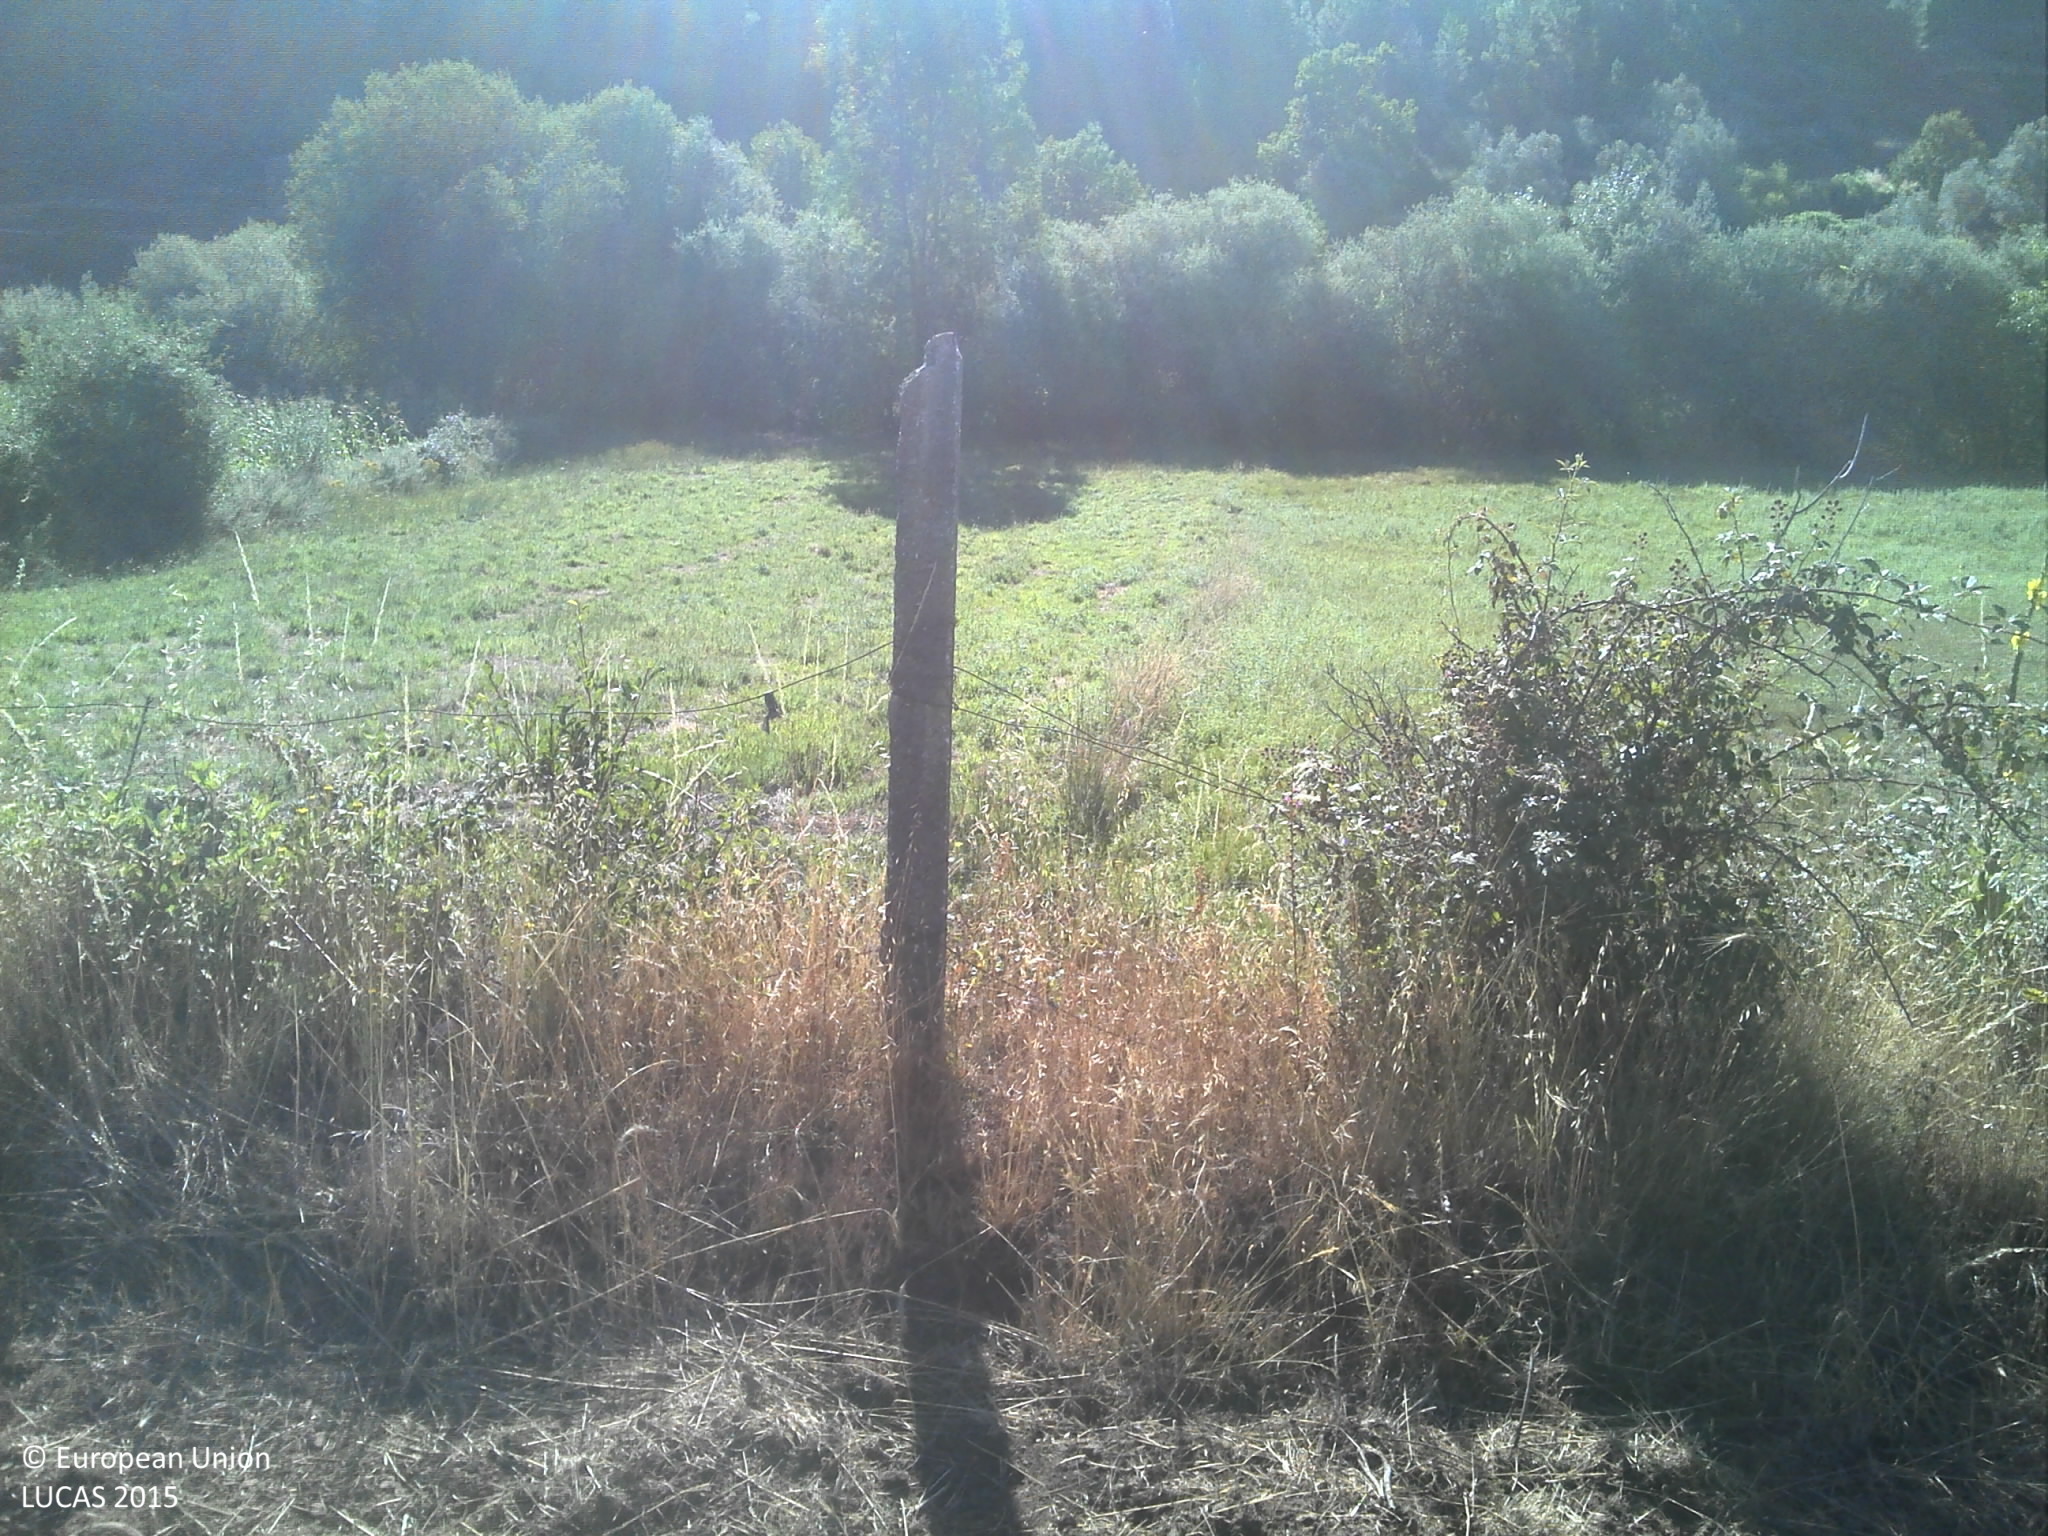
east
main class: Grassland
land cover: Spontaneously vegetated surfaces
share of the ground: 10 - 25 %
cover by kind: unconsolidated bare surface 80 %, herbaceous plants 20 %
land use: Fallow land
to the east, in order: Spontaneously vegetated surfaces; Dry stone walls; Grassland without tree/shrub cover; Broadleaved woodland; Inland fresh running water; Broadleaved woodland; Spontaneously vegetated surfaces; Dry stone walls; Olive groves; Dry stone walls; Tracks; Pine dominated coniferous woodland
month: July
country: PT
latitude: 40.3642
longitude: -7.4778
